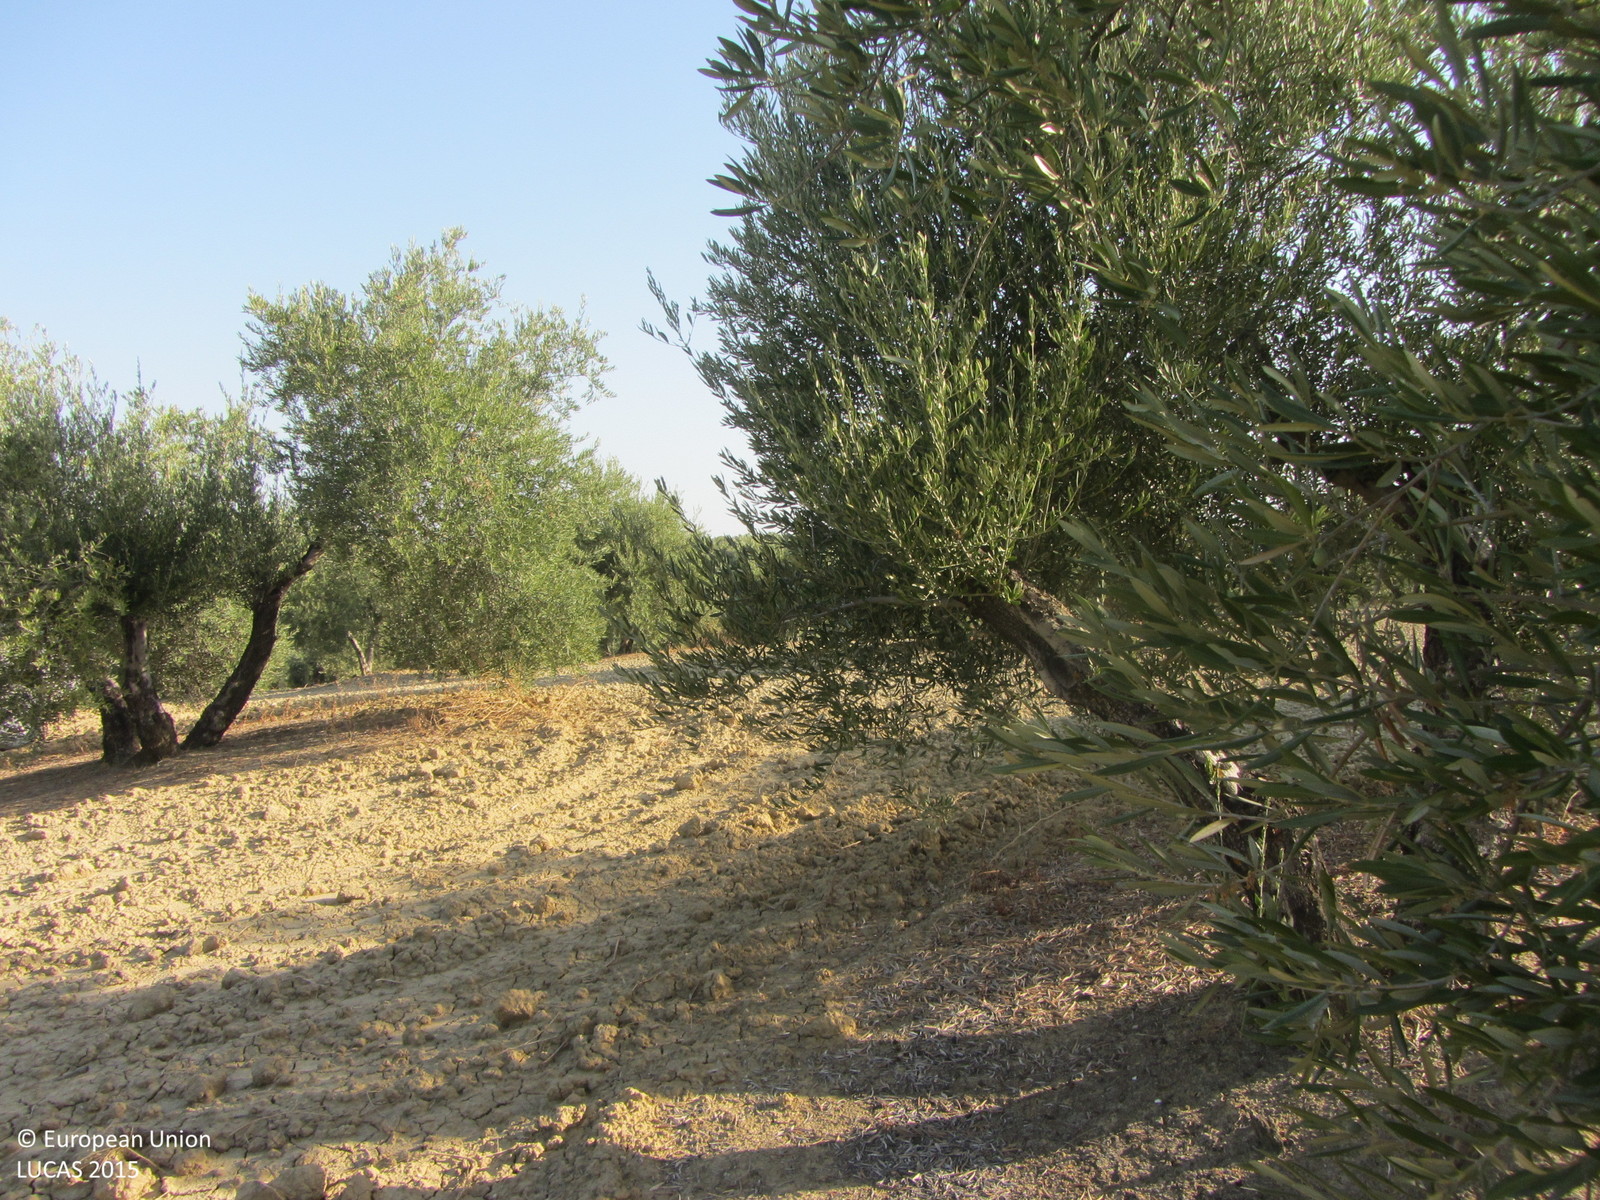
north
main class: Cropland
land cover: Olive groves
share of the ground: 25 - 50 %
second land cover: Other bare soil
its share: > 75 %
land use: Agriculture (excluding fallow land and kitchen gardens)
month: July
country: ES
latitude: 37.9442
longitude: -4.1980
